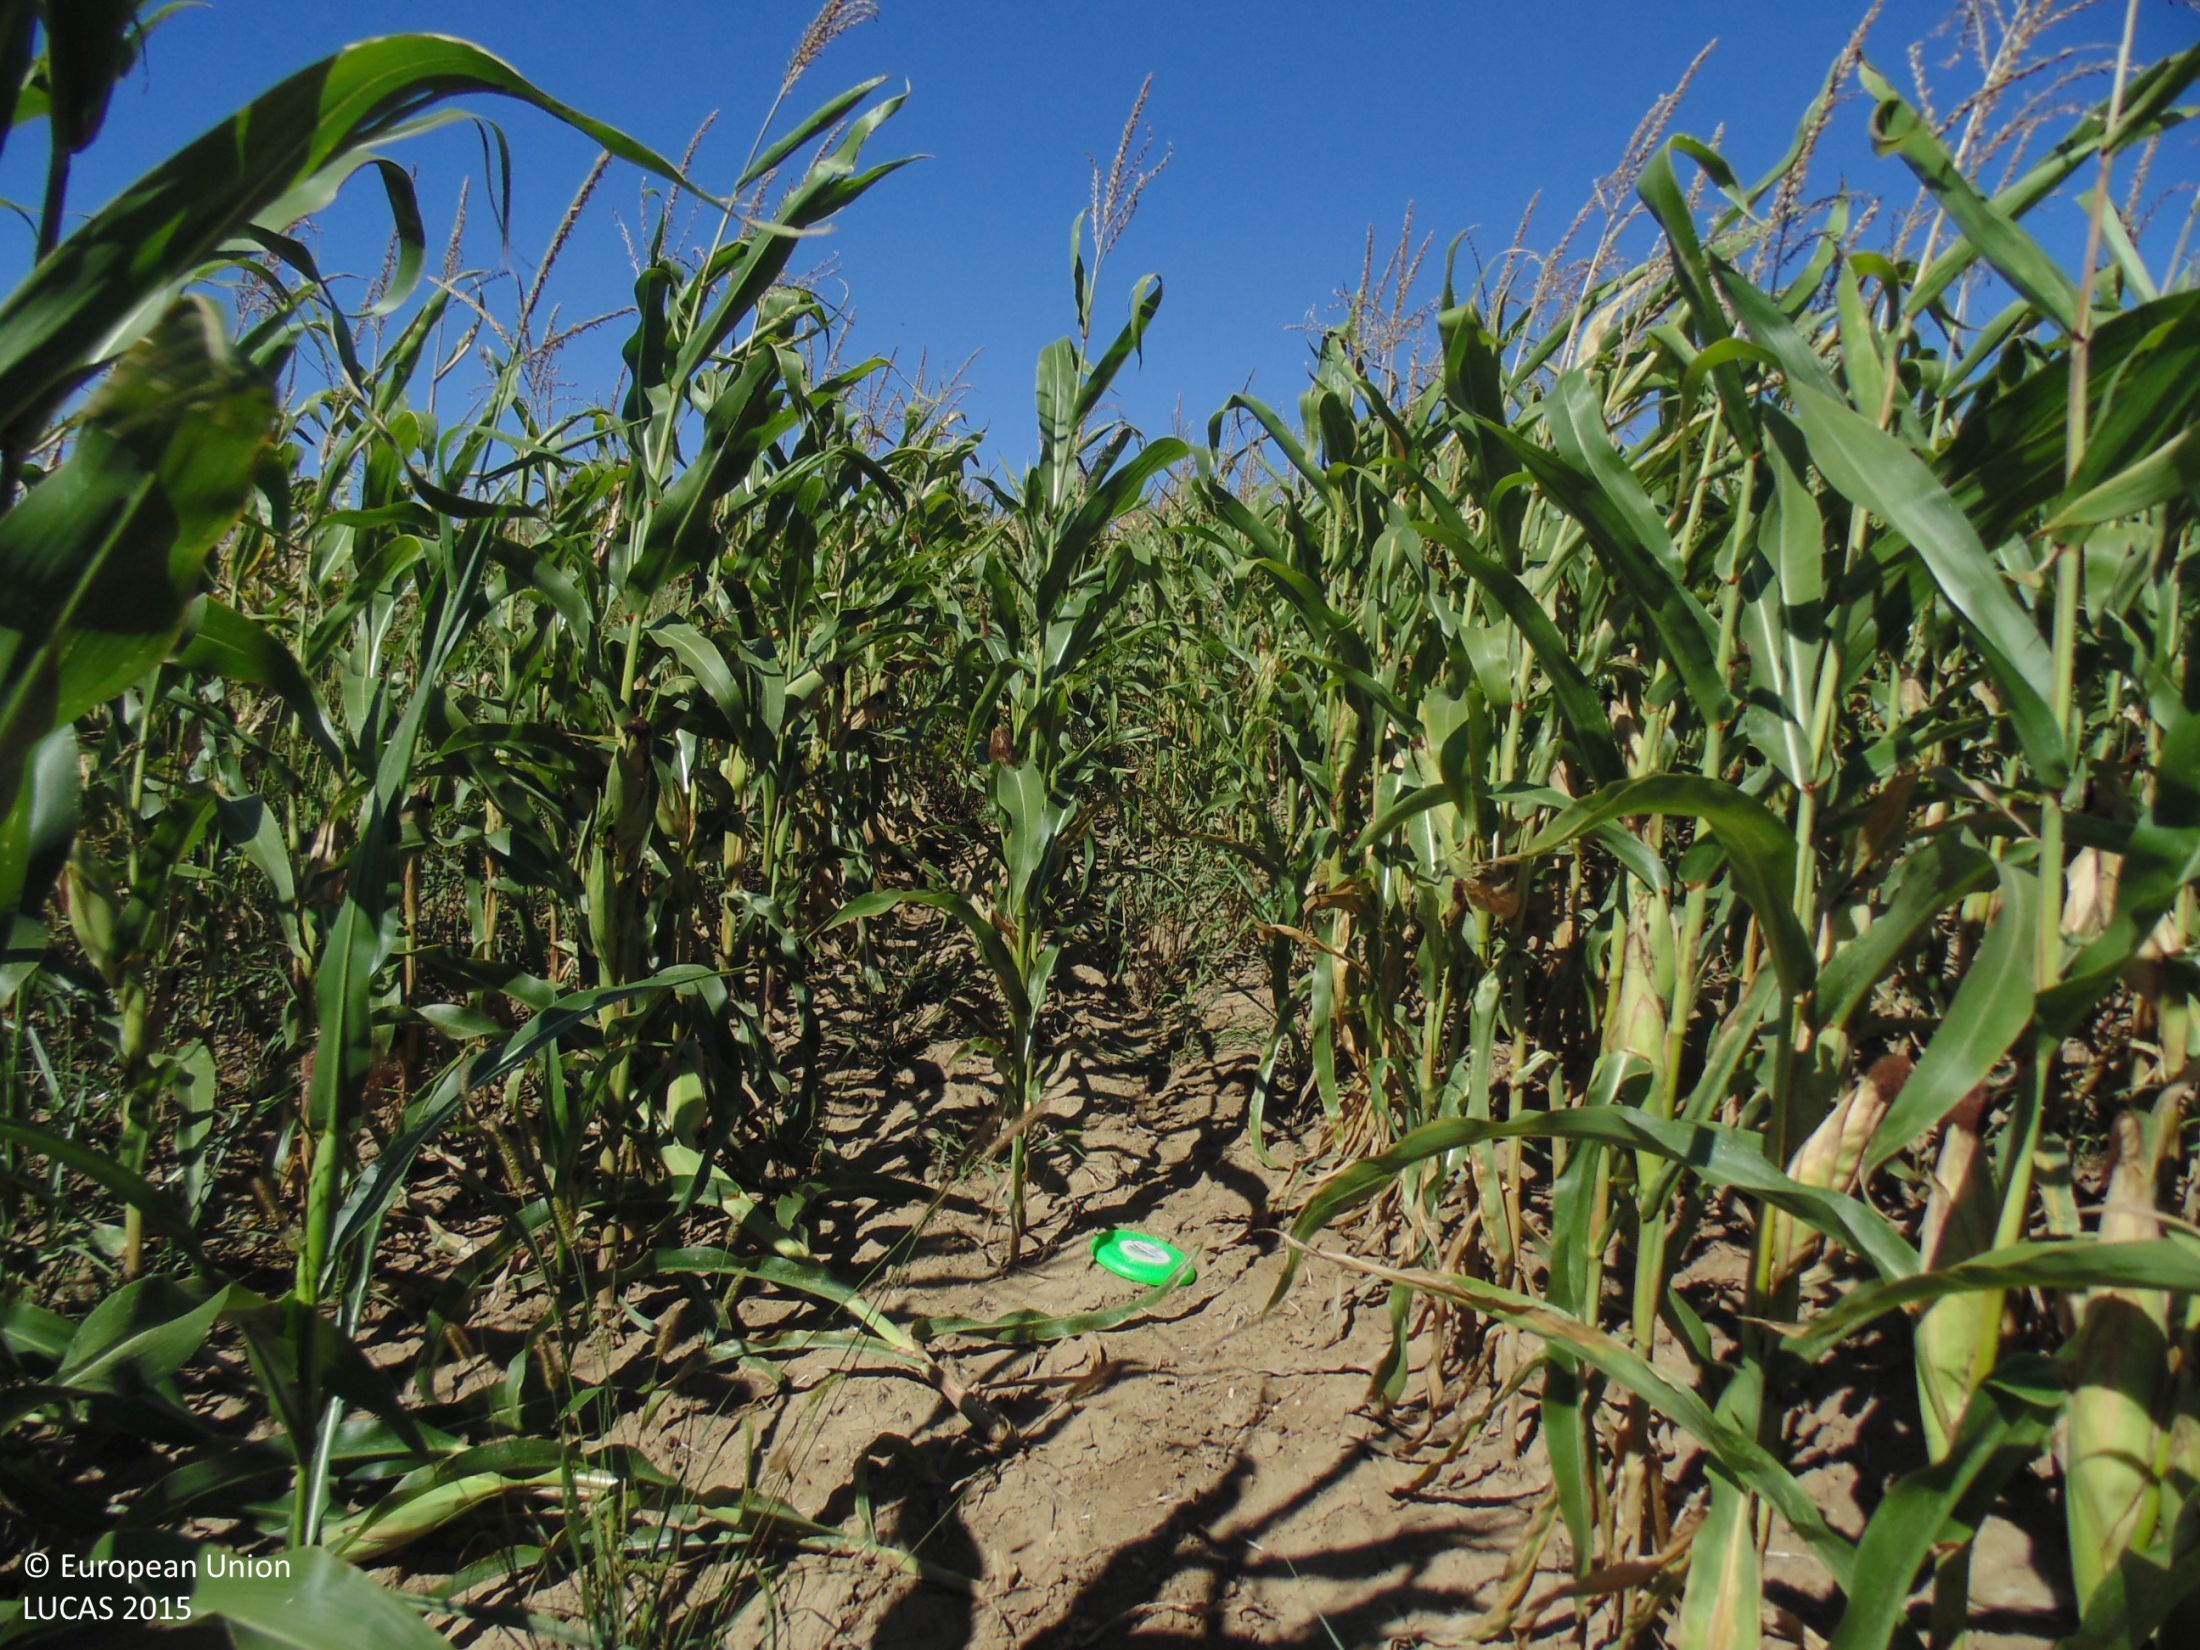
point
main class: Cropland
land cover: Maize
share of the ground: > 75 %
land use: Agriculture (excluding fallow land and kitchen gardens)
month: September
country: BG
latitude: 43.7930
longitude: 27.3682
